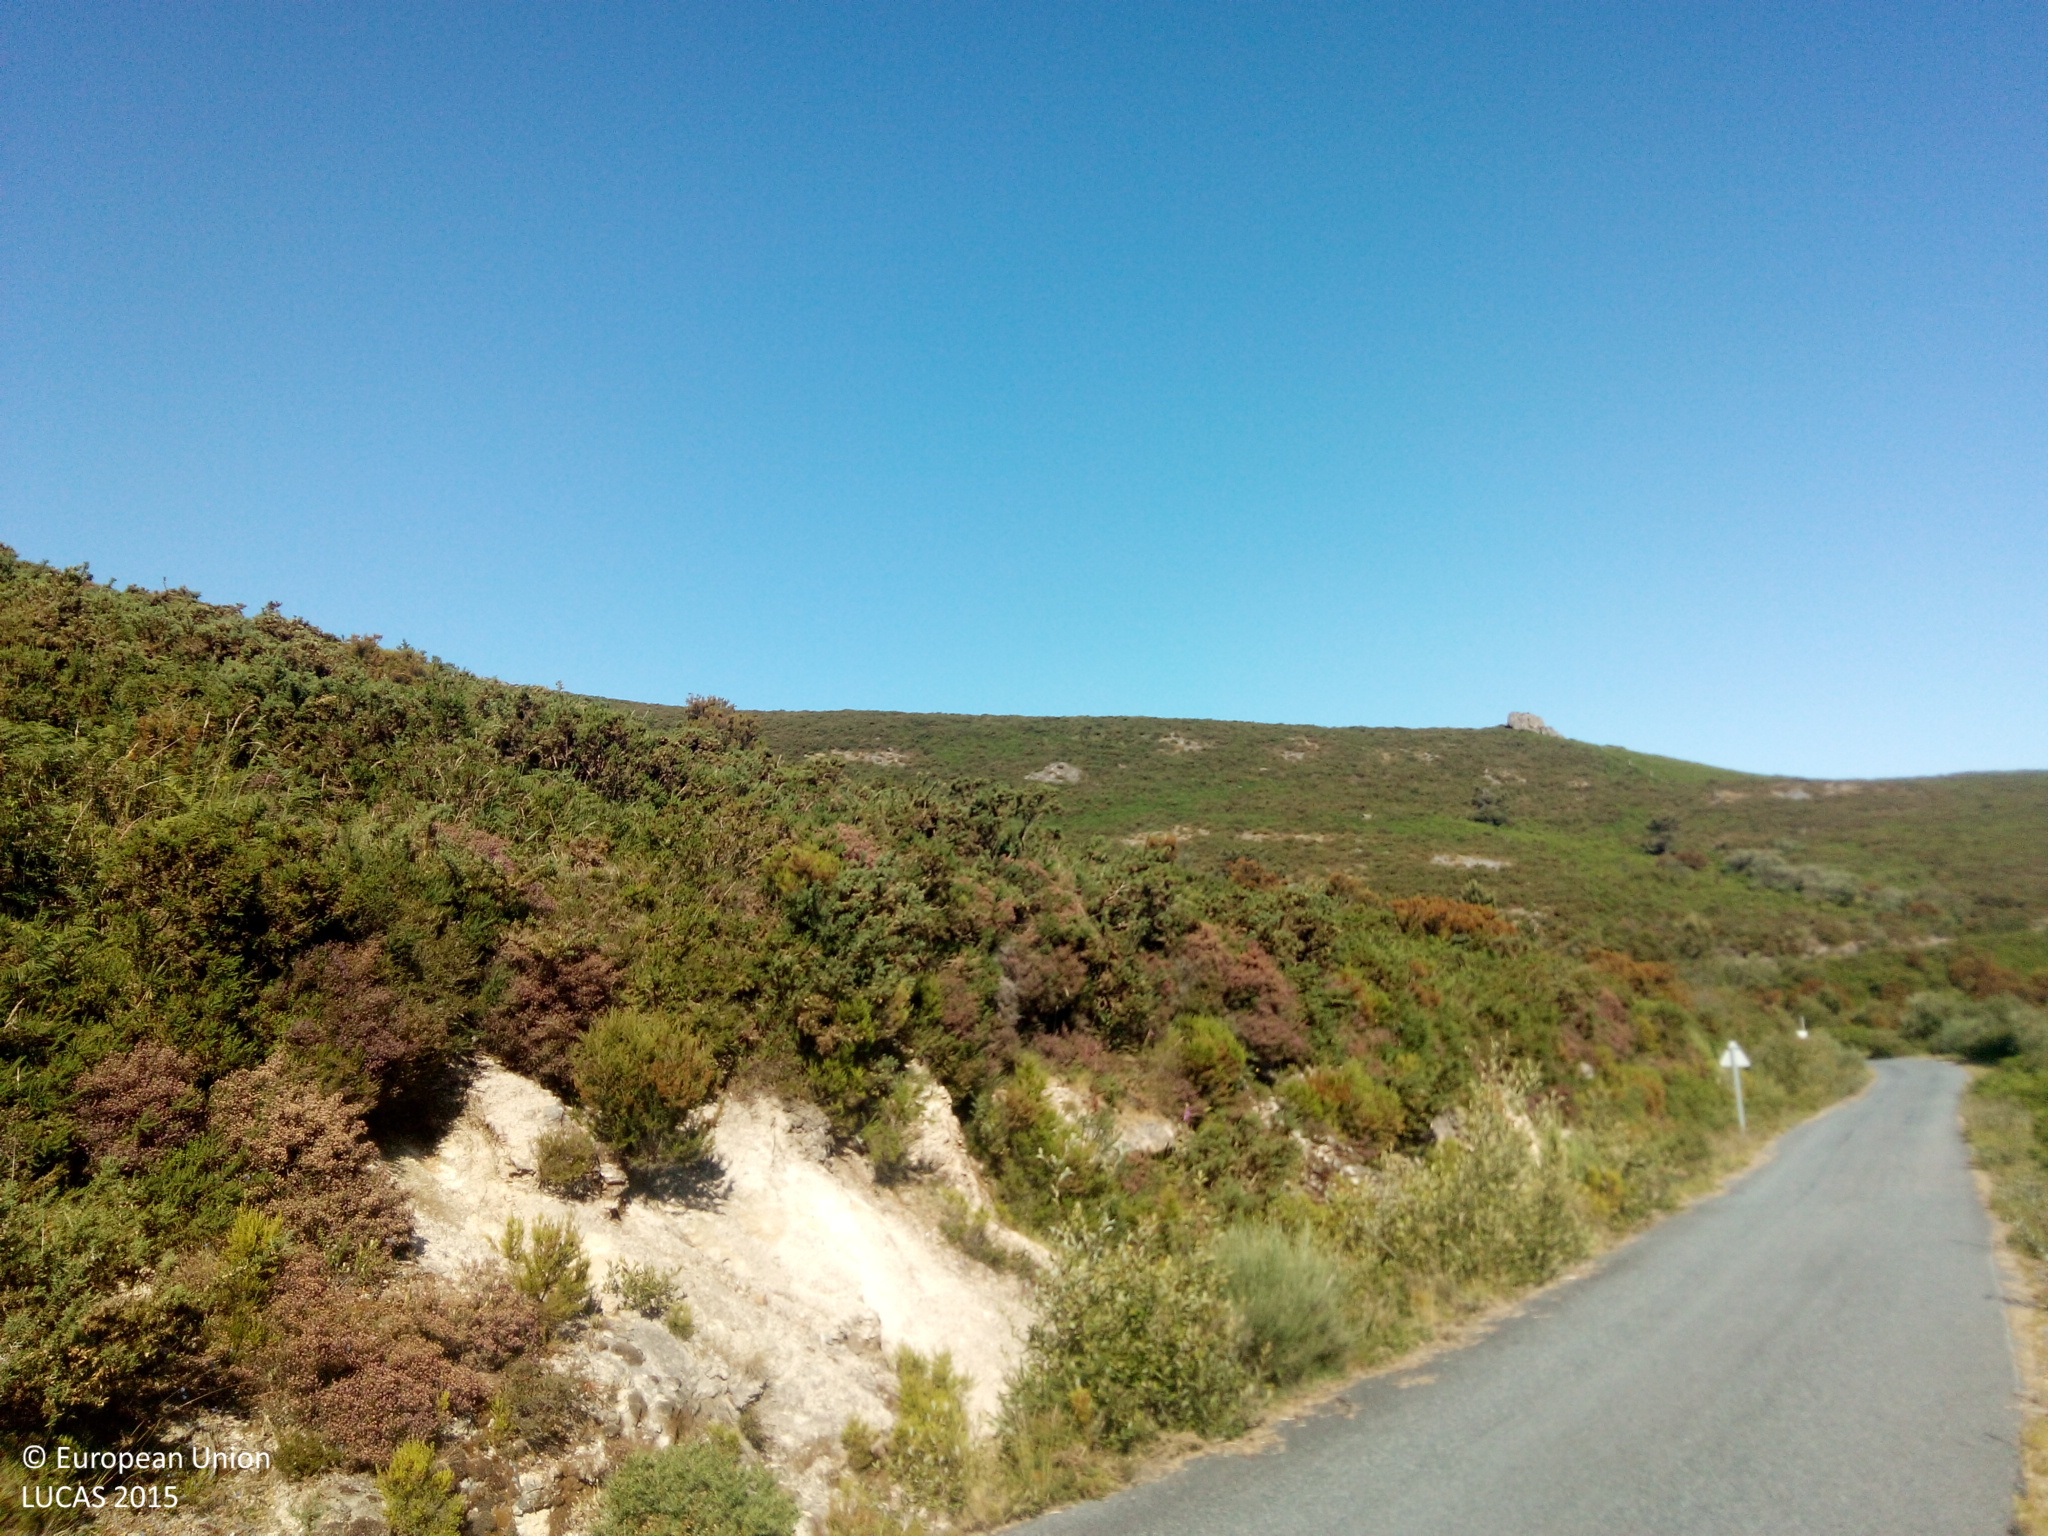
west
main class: Shrubland
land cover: Shrubland without tree cover
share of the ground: > 75 %
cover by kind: shrubs 100 %
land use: Abandoned areas
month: June
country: ES
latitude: 42.5099
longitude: -8.3619
